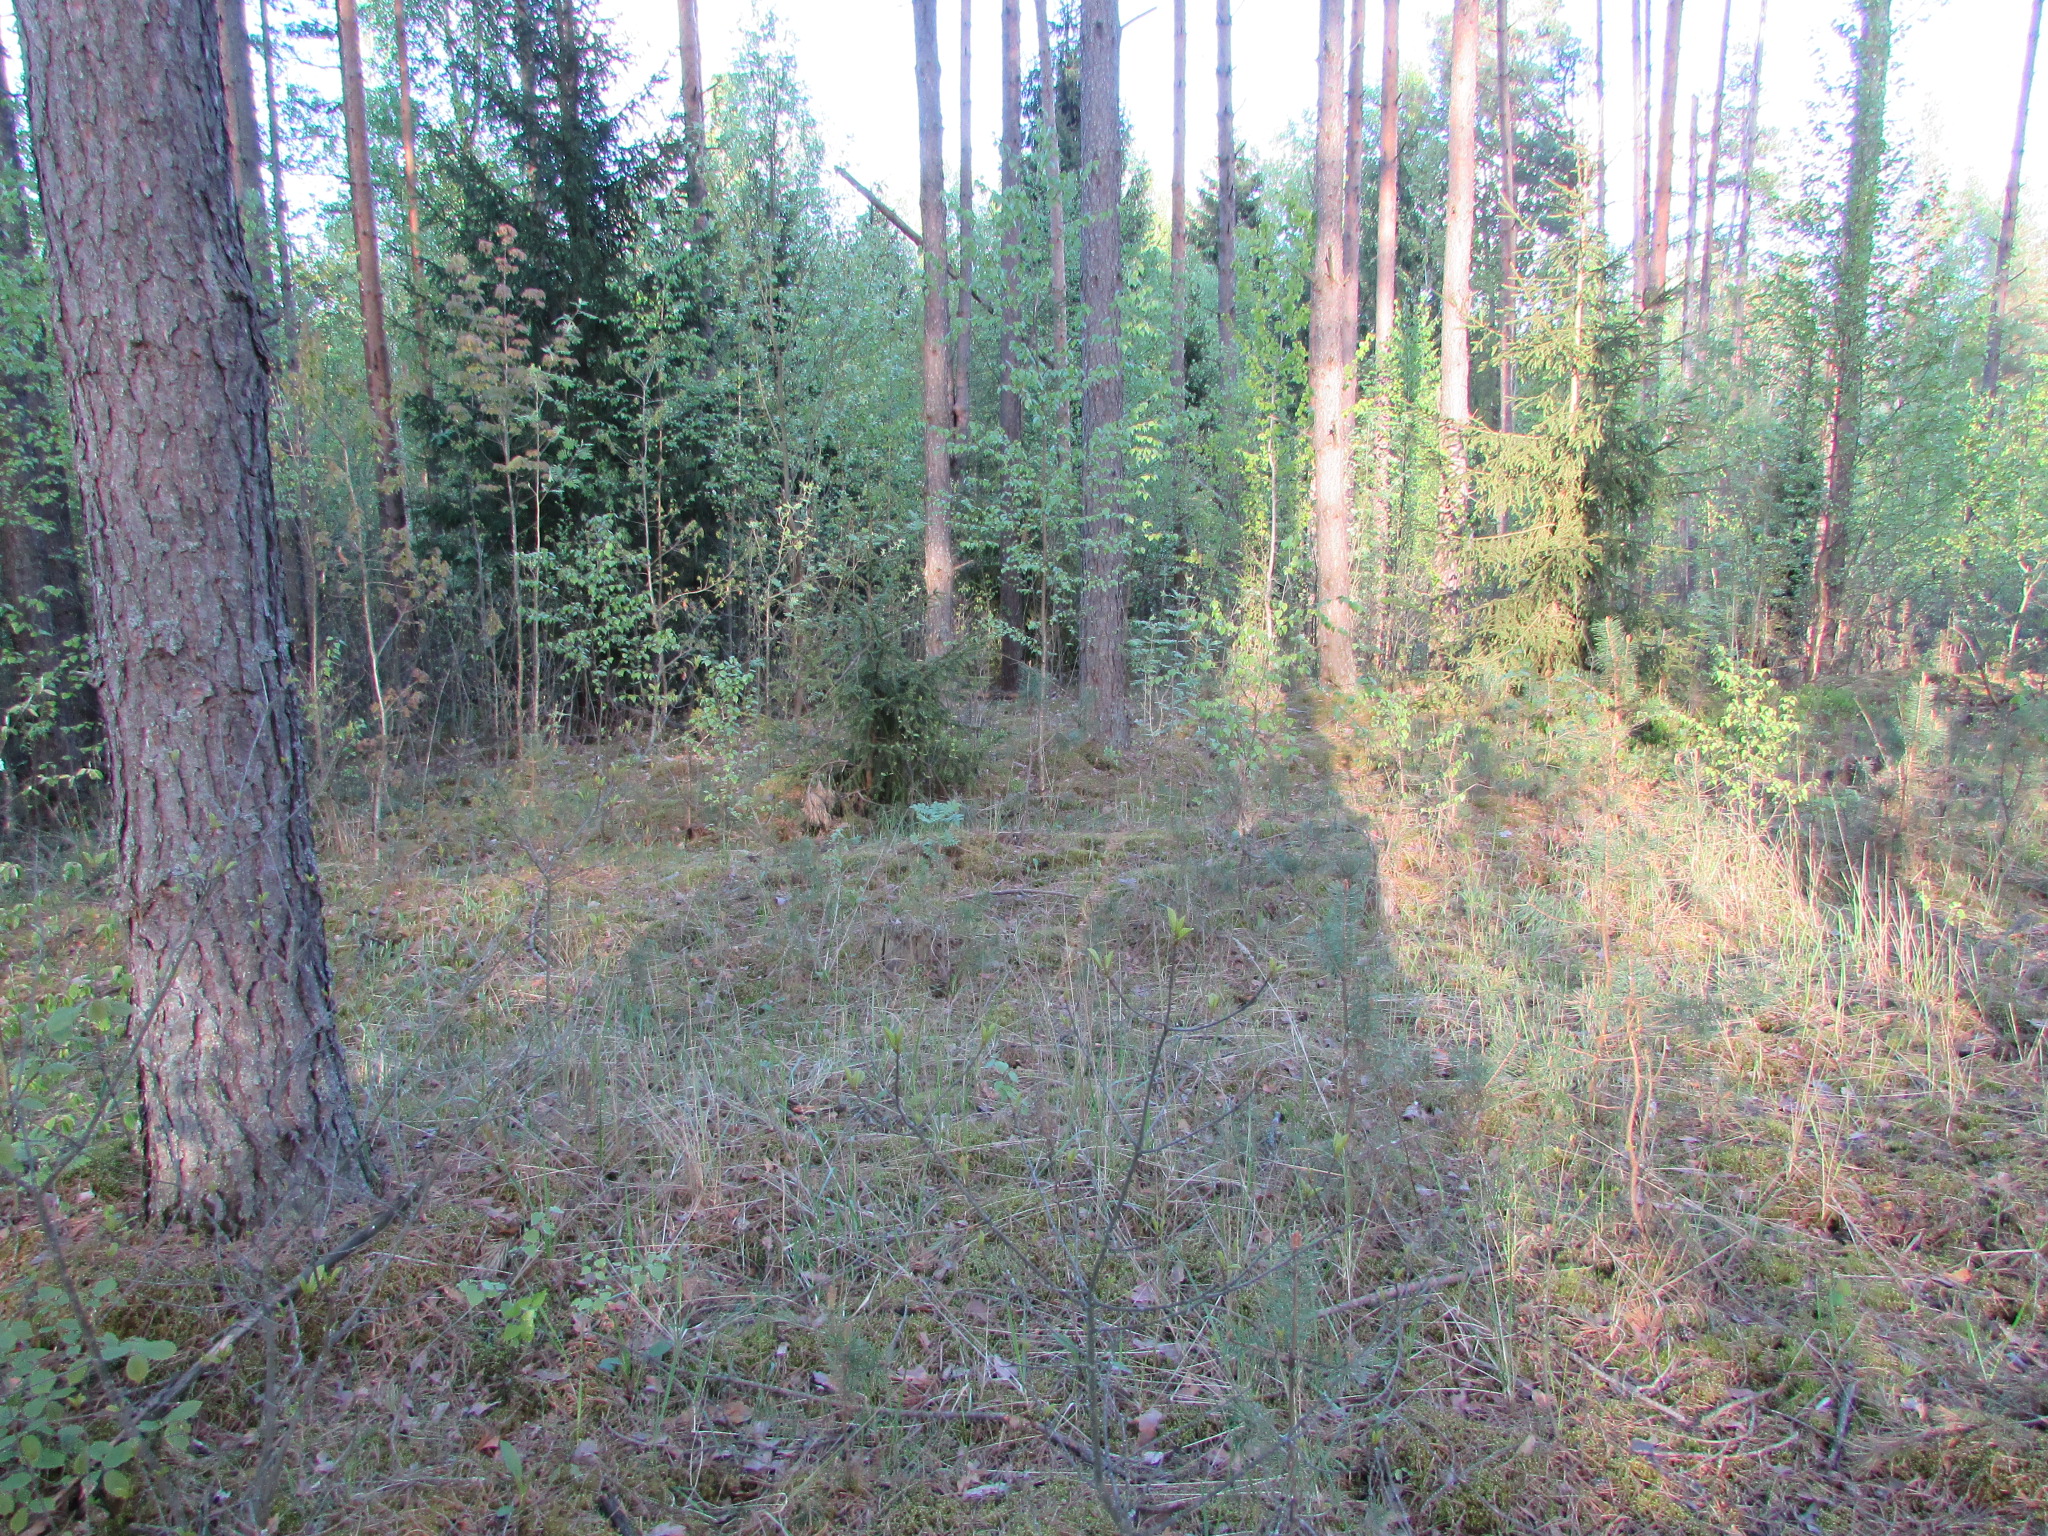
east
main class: Woodland
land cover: Pine dominated coniferous woodland
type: hemiboreal forest and nemoral coniferous forest and mixed broadleaved-coniferous forest
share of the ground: > 75 %
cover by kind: coniferous forest trees 90 %, broadleaved forest trees 10 %
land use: Forestry
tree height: > 5 m
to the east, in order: Pine dominated coniferous woodland; Broadleaved woodland; Pine dominated mixed woodland; Broadleaved woodland; Inland marshes
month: May
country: LV
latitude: 56.1749
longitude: 27.1967
